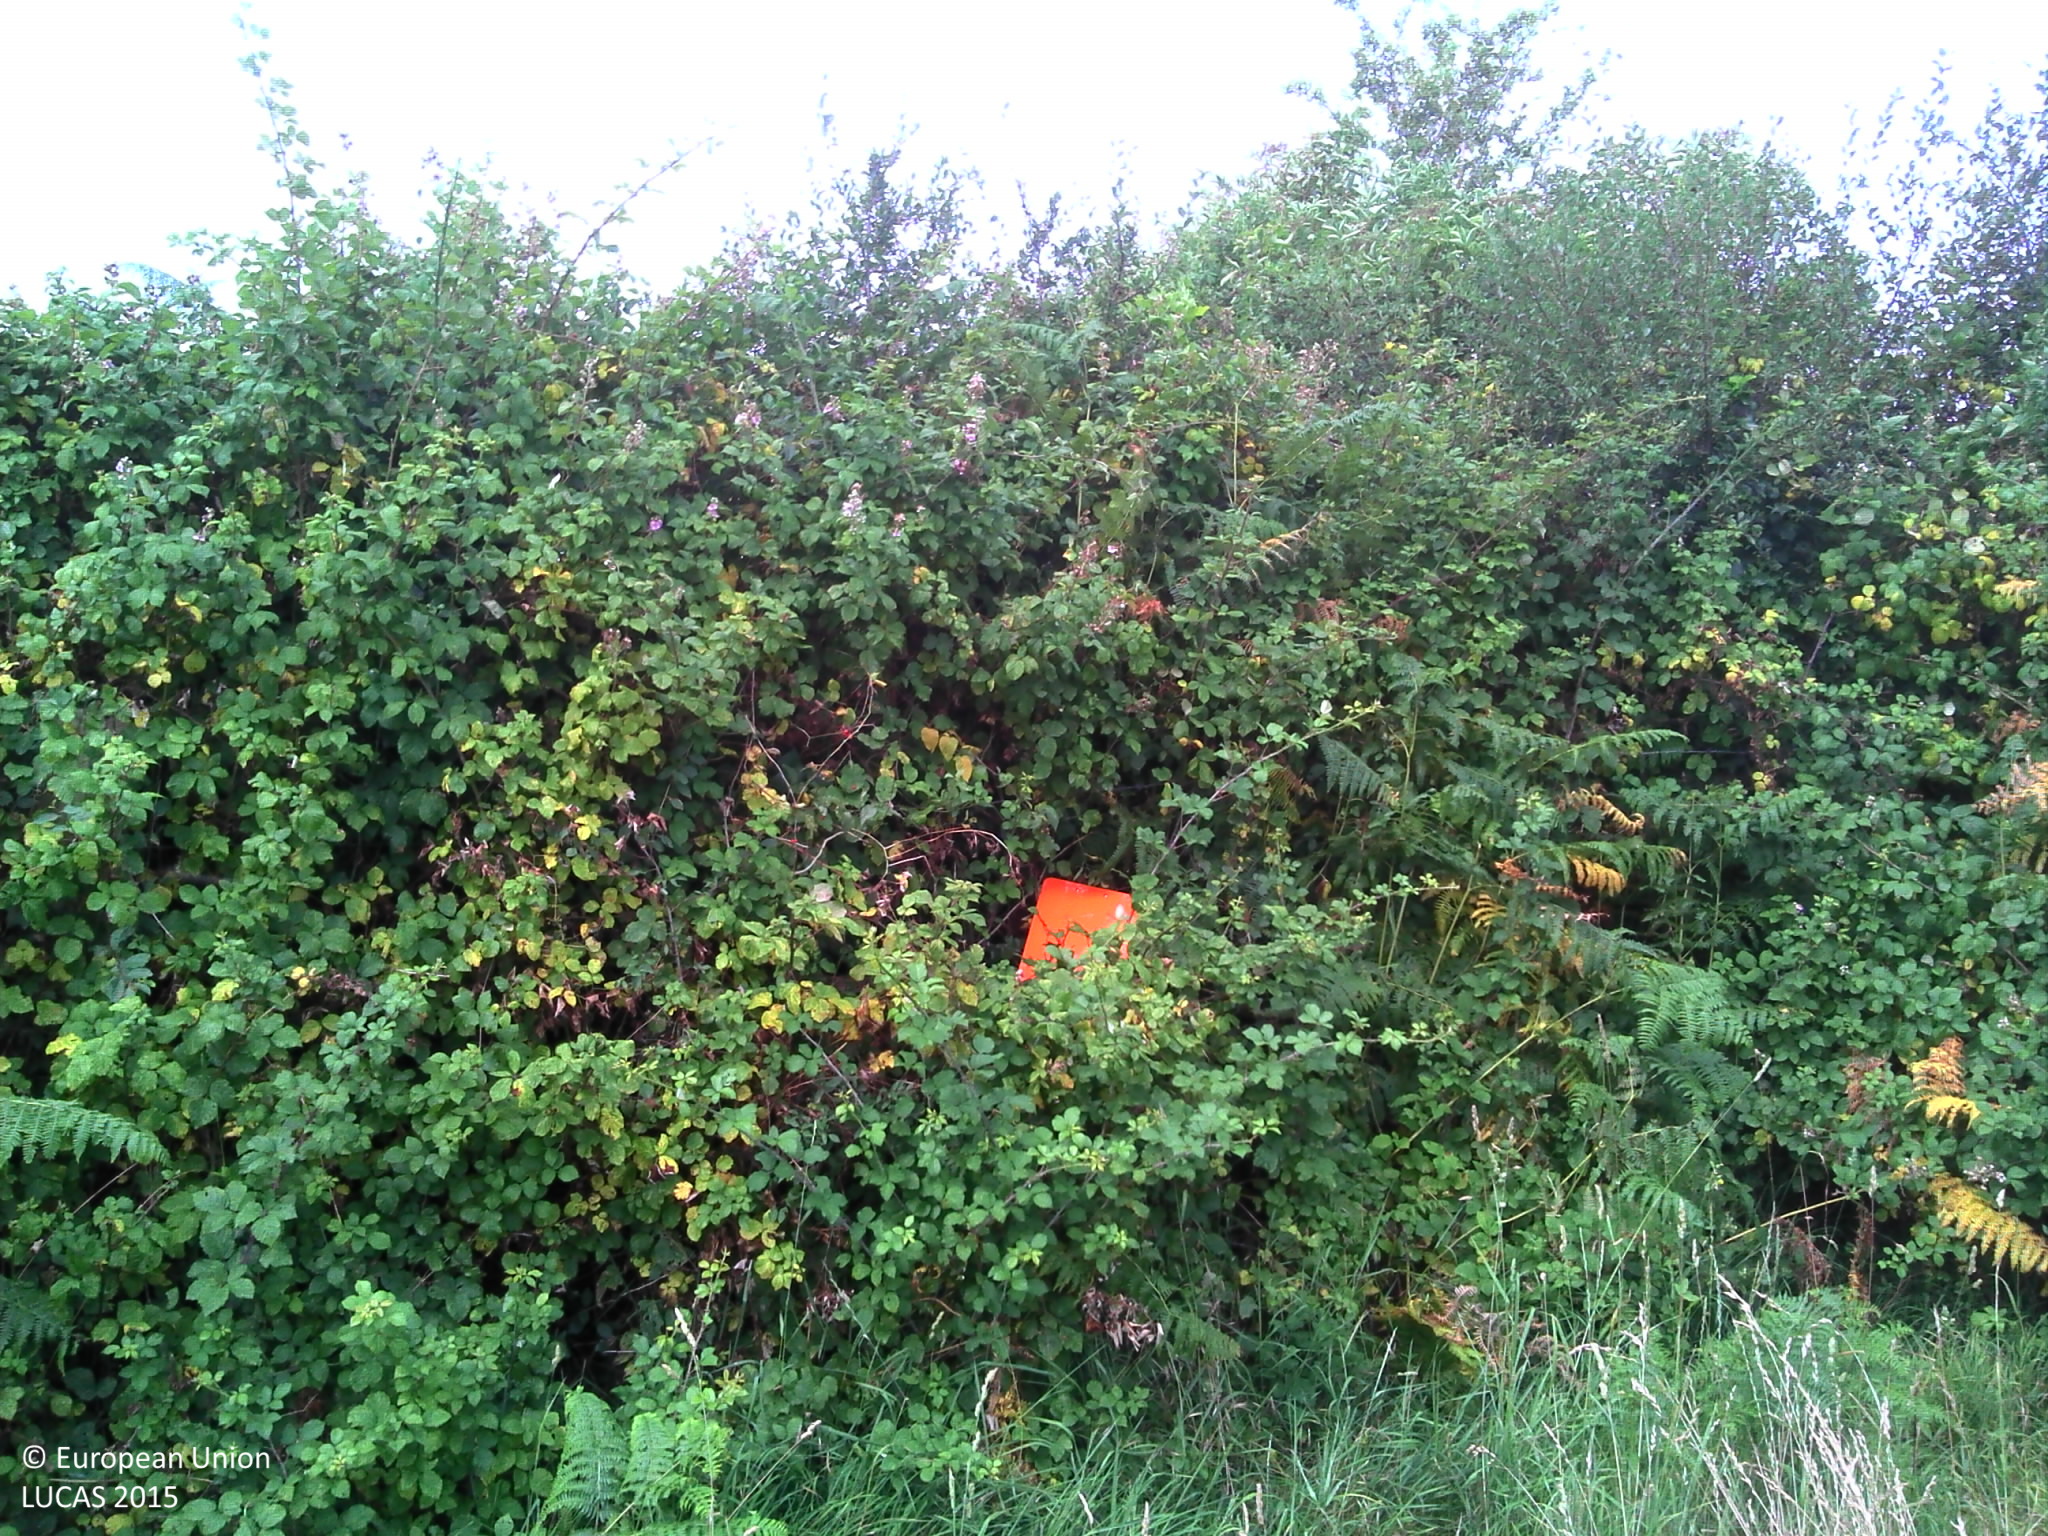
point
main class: Grassland
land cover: Grassland with sparse tree/shrub cover
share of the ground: > 75 %
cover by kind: herbaceous plants 95 %, broadleaved forest trees 5 %
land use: Agriculture (excluding fallow land and kitchen gardens)
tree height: > 5 m
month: July
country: FR
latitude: 47.2663
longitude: -1.7417
